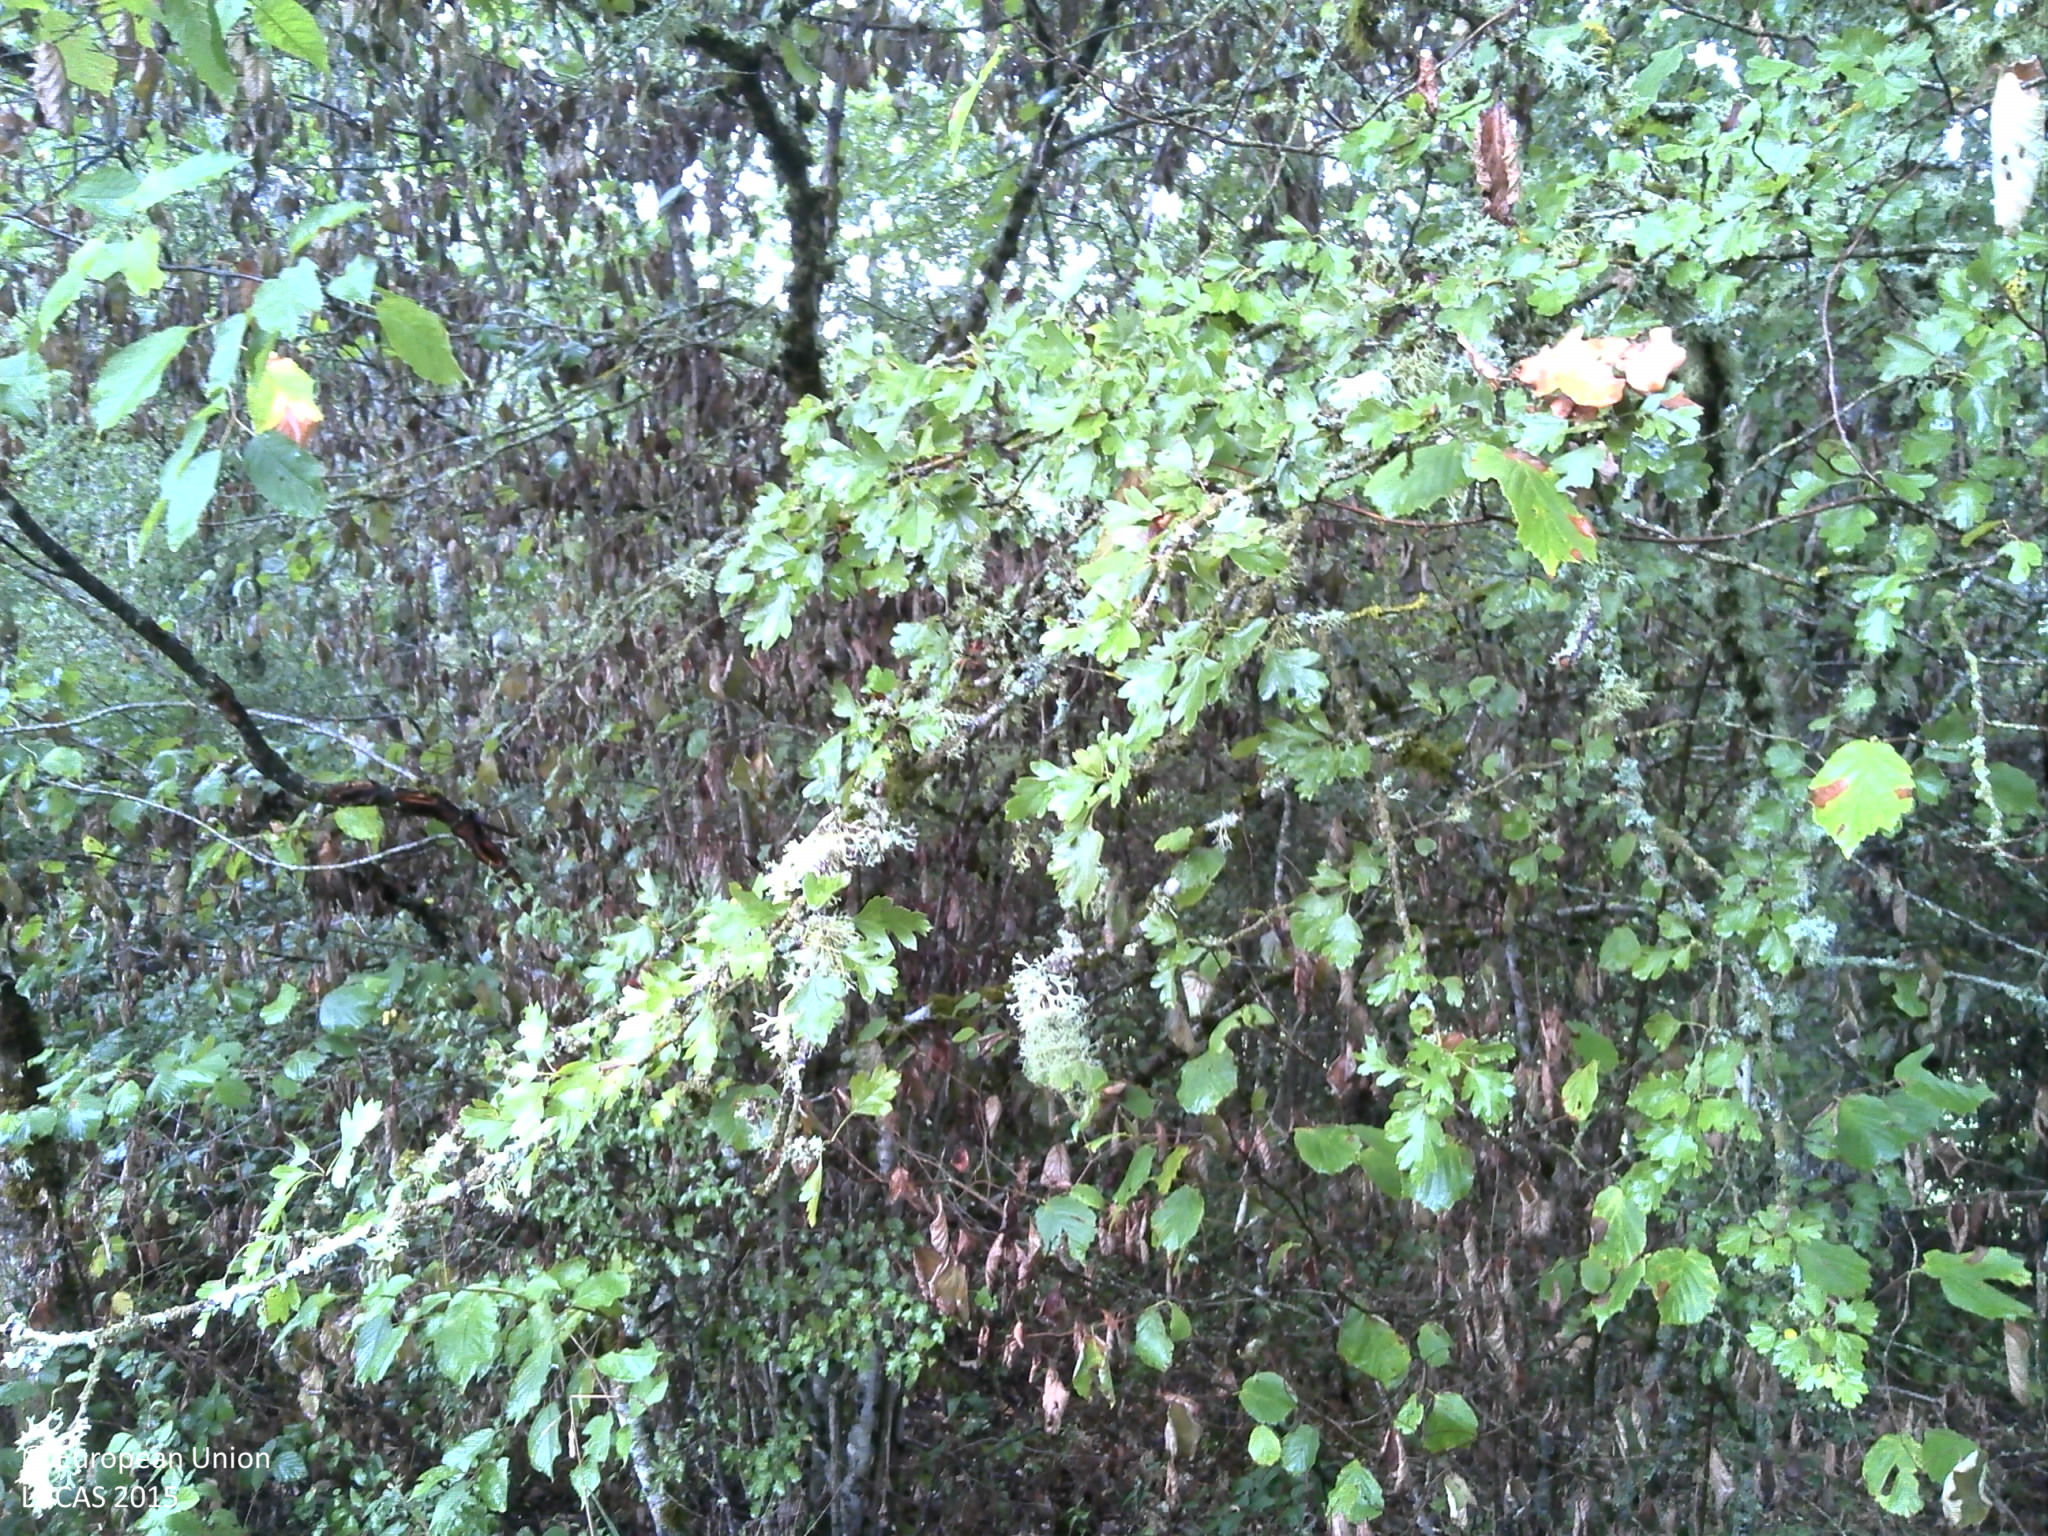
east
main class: Grassland
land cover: Grassland without tree/shrub cover
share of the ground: > 75 %
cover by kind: herbaceous plants 90 %, unconsolidated bare surface 10 %
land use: Agriculture (excluding fallow land and kitchen gardens)
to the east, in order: Grassland without tree/shrub cover; Broadleaved woodland; Fences; Other leguminous and mixtures for fodder; Broadleaved woodland; Other leguminous and mixtures for fodder; Fences; Broadleaved woodland; Grassland without tree/shrub cover
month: August
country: FR
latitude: 45.4306
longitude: 2.4187
